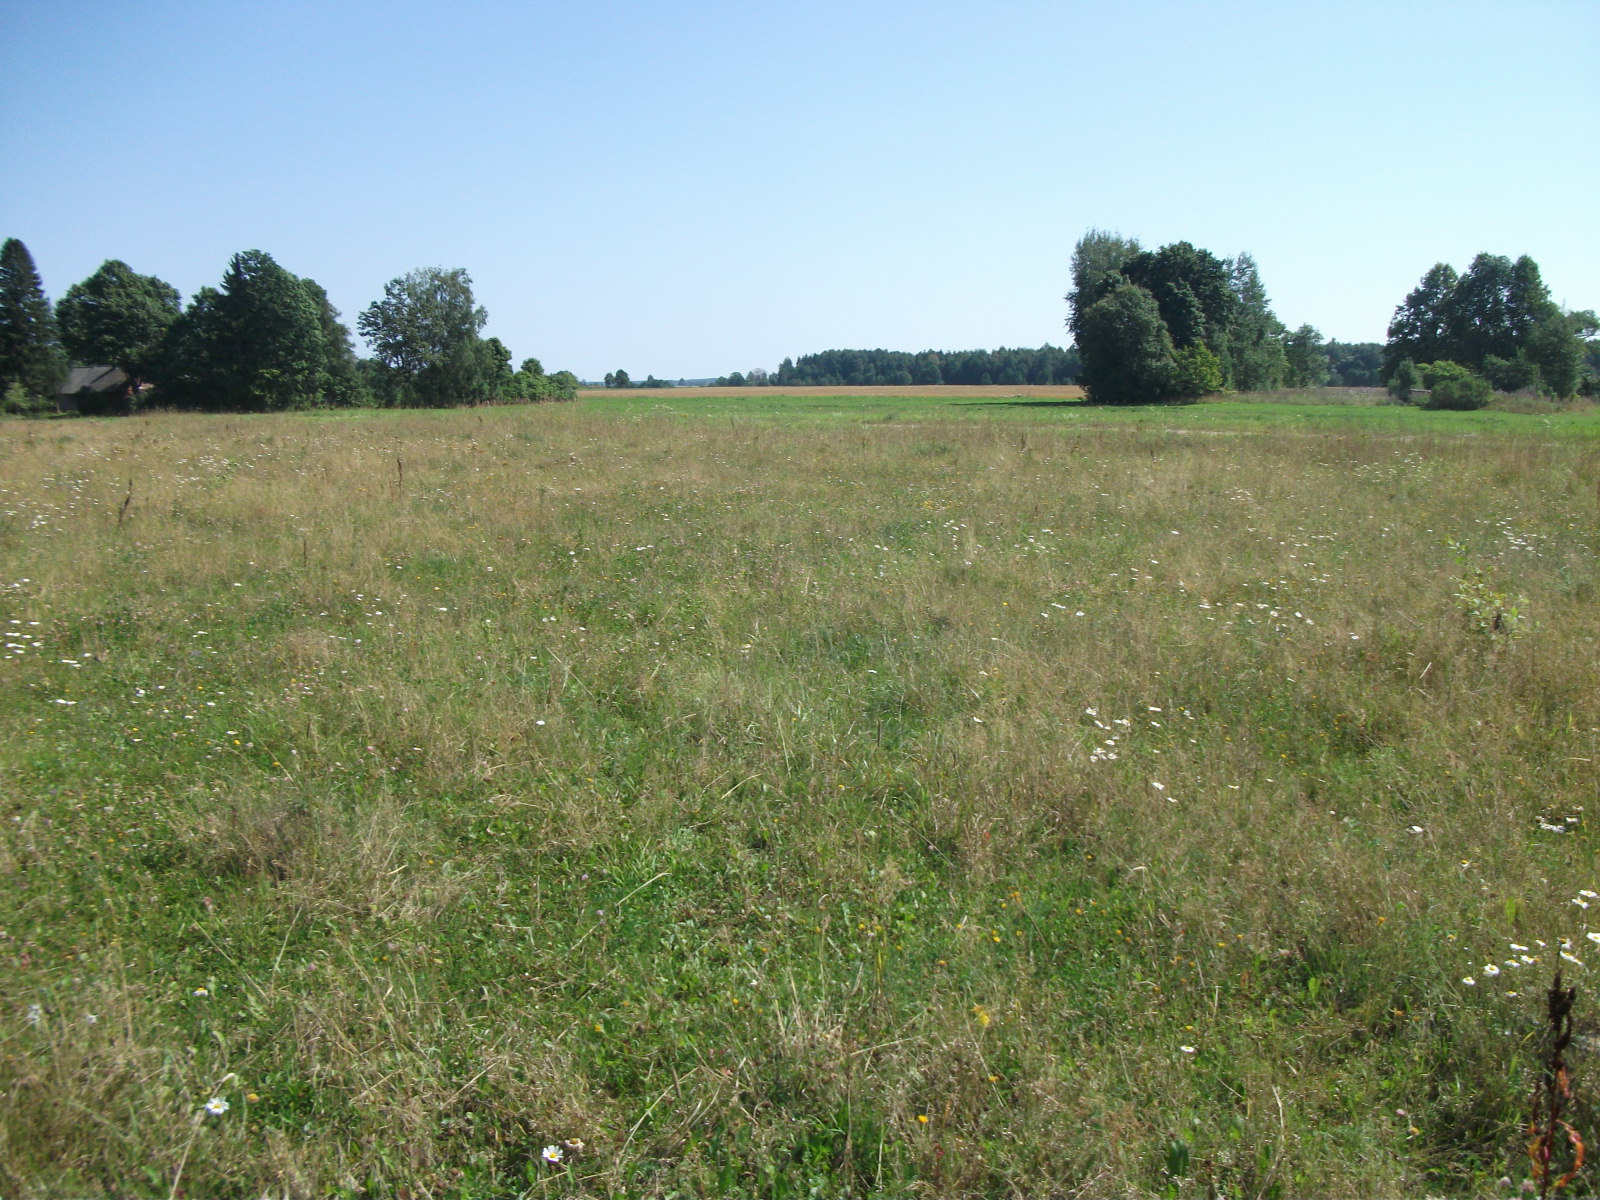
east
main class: Grassland
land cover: Grassland without tree/shrub cover
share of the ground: > 75 %
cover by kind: herbaceous plants 100 %
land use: Agriculture (excluding fallow land and kitchen gardens)
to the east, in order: Grassland without tree/shrub cover; Fences; Grass margins; Paved roads, cycling and walking lanes; Grassland without tree/shrub cover
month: August
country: LV
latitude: 56.6534
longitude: 26.5075
